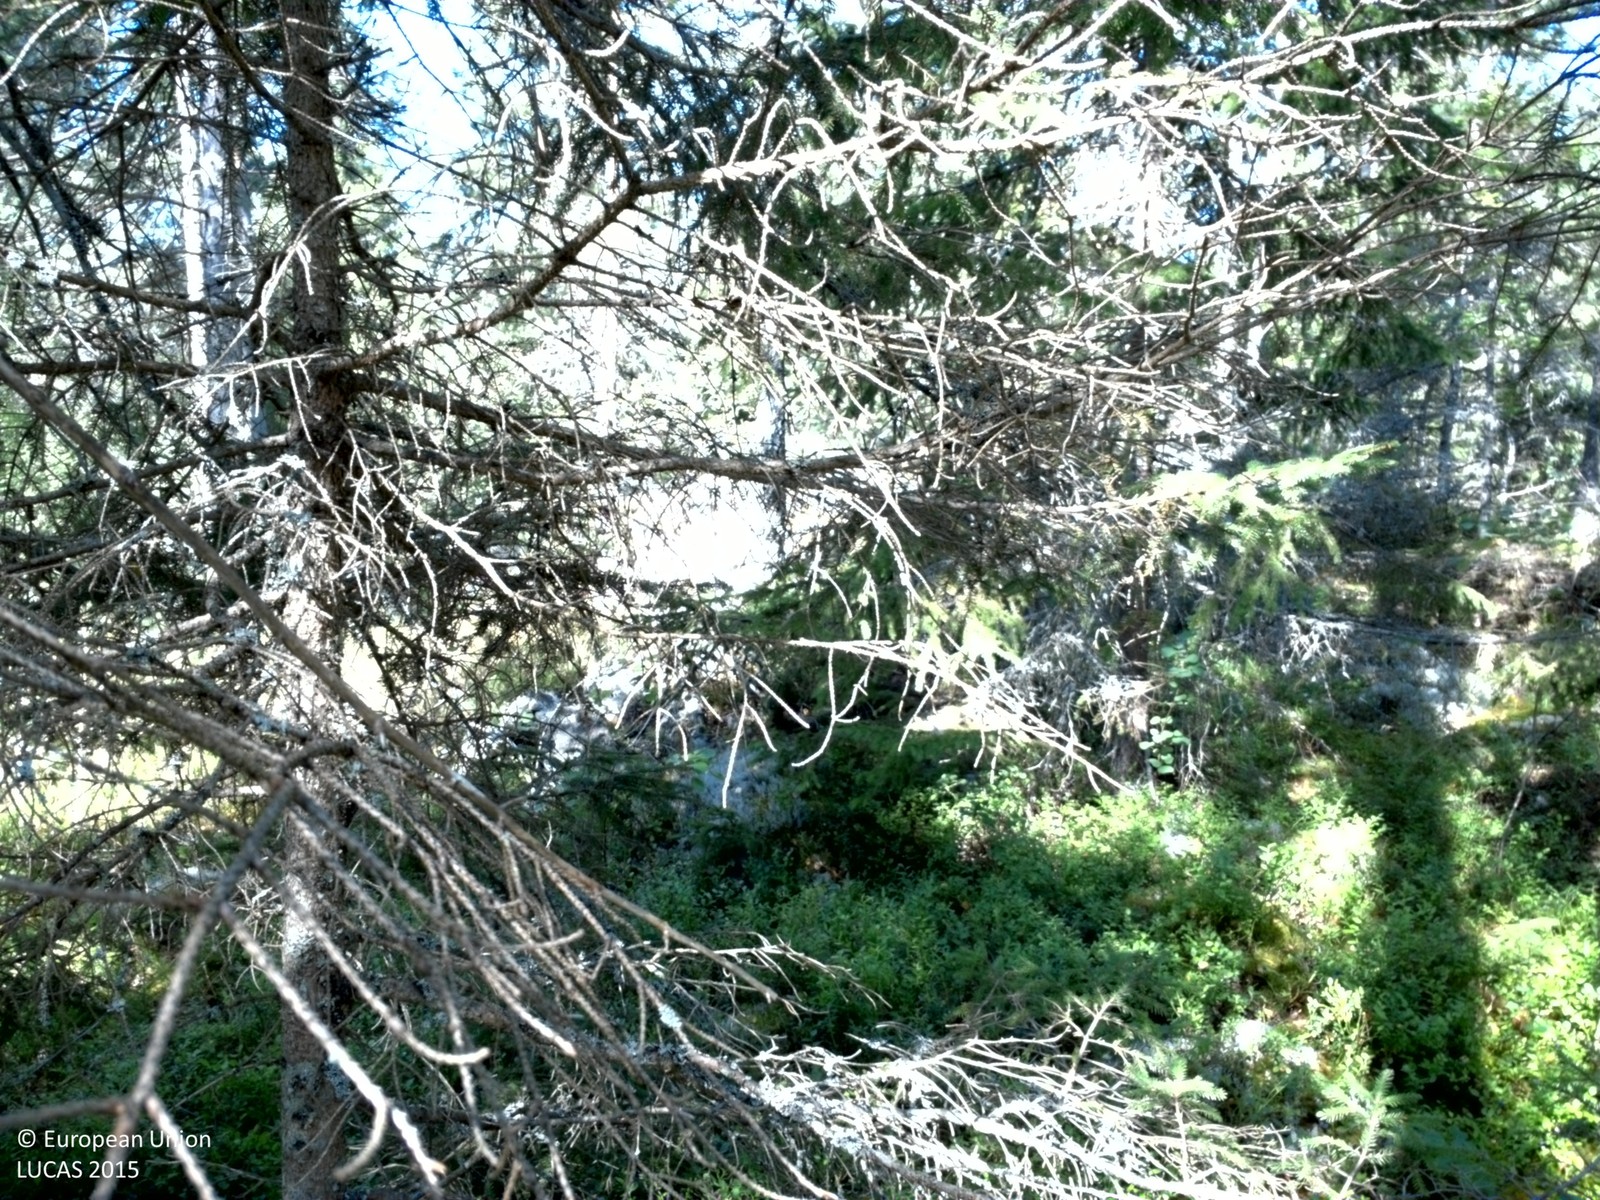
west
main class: Woodland
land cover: Spruce dominated coniferous woodland
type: boreal forest
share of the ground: > 75 %
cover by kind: coniferous forest trees 70 %, lichens and mosses 25 %, broadleaved forest trees 5 %
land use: Forestry
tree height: > 5 m
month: August
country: SE
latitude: 59.5452
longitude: 18.4723
